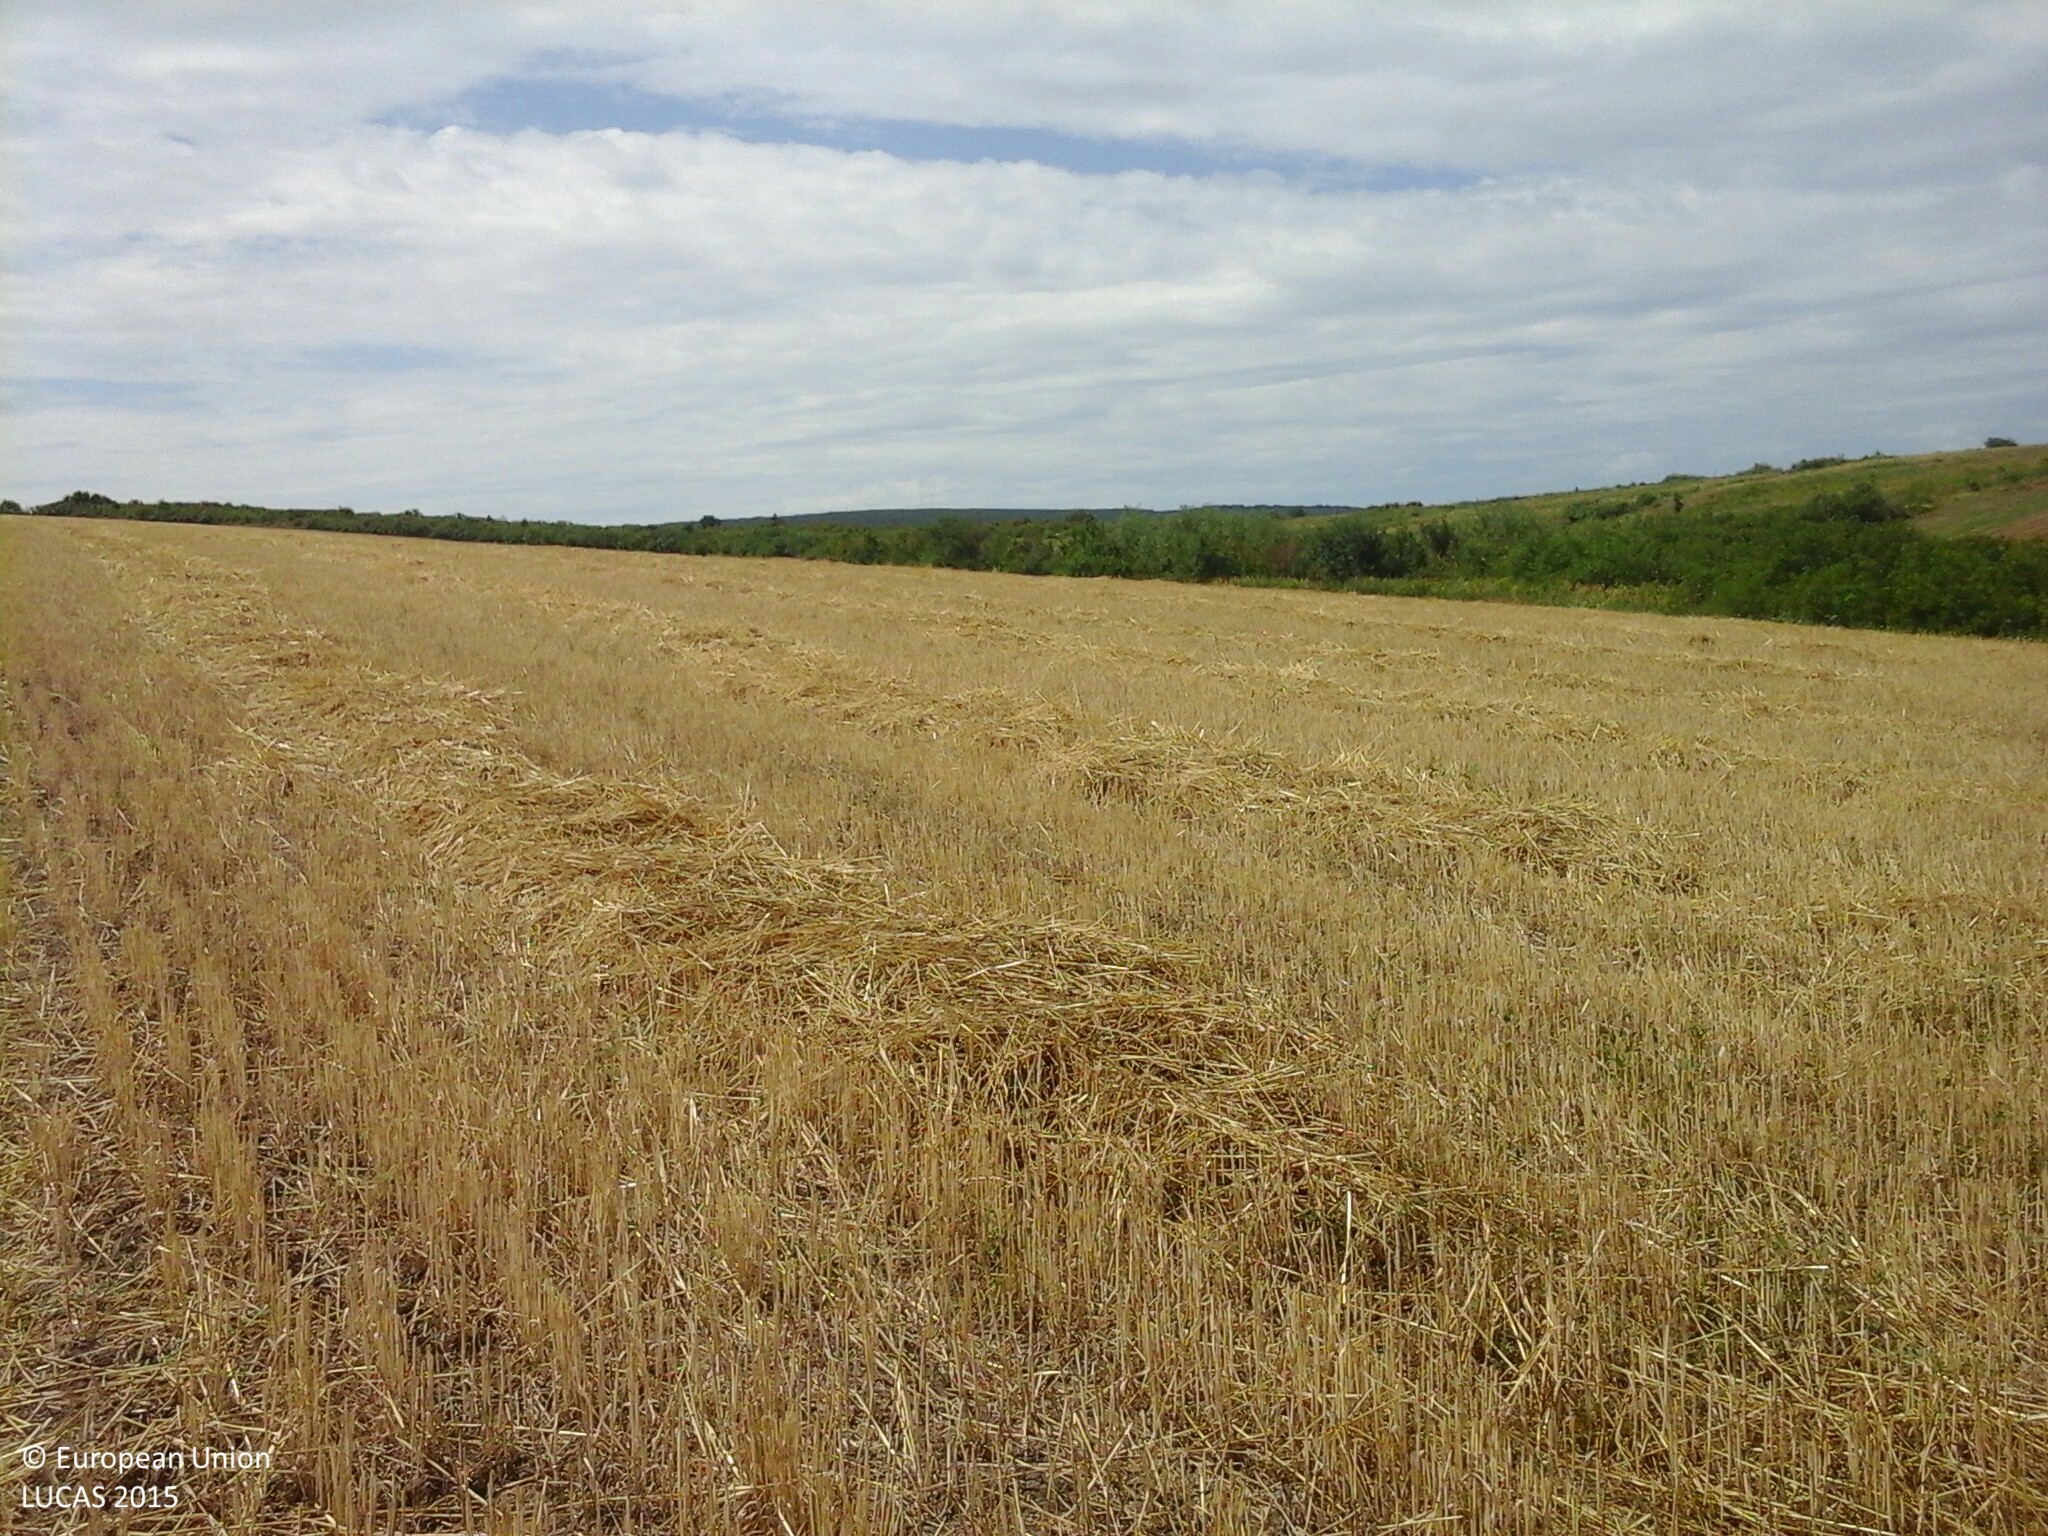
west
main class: Cropland
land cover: Common wheat
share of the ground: 50 - 75 %
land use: Agriculture (excluding fallow land and kitchen gardens)
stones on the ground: < 10 %
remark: Harvested field
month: July
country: HU
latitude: 47.9420
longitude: 20.6509
